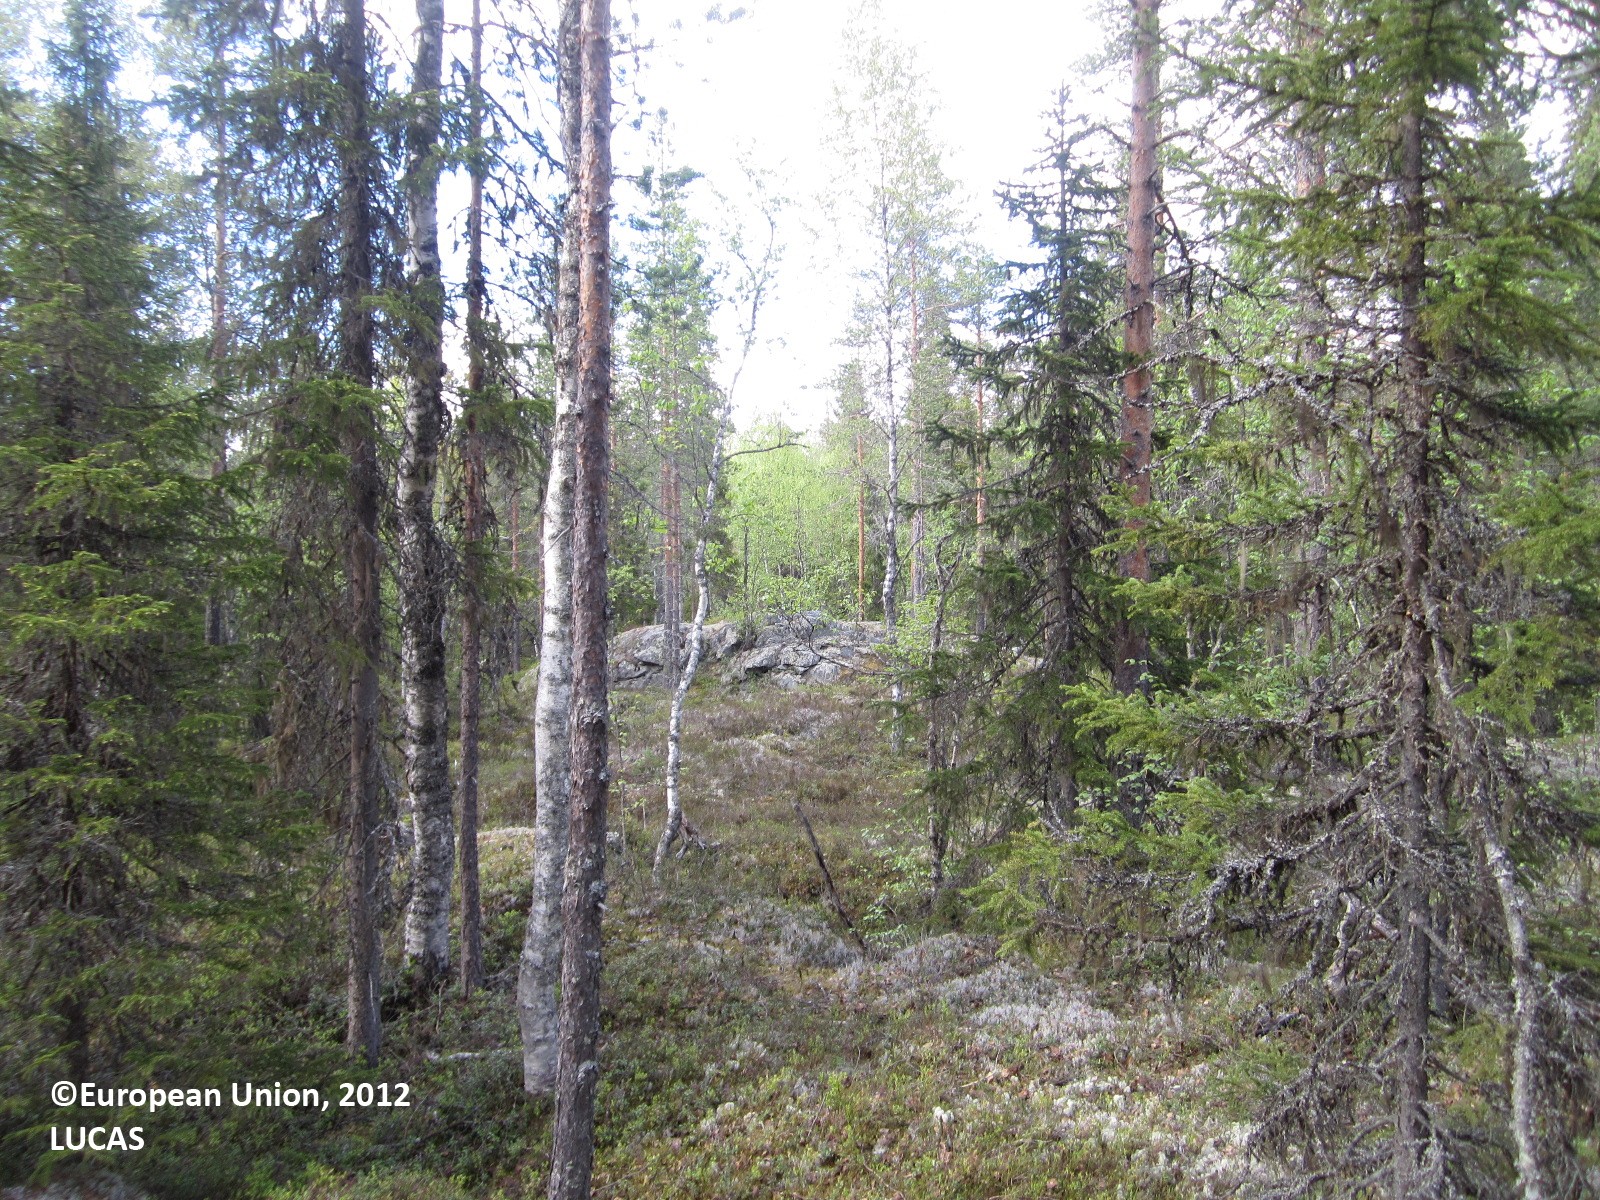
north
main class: Woodland
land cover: Other coniferous woodland
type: boreal forest
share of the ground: 50 - 75 %
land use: Semi-natural and natural areas not in use
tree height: > 5 m
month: June
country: FI
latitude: 64.5921
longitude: 28.5807
